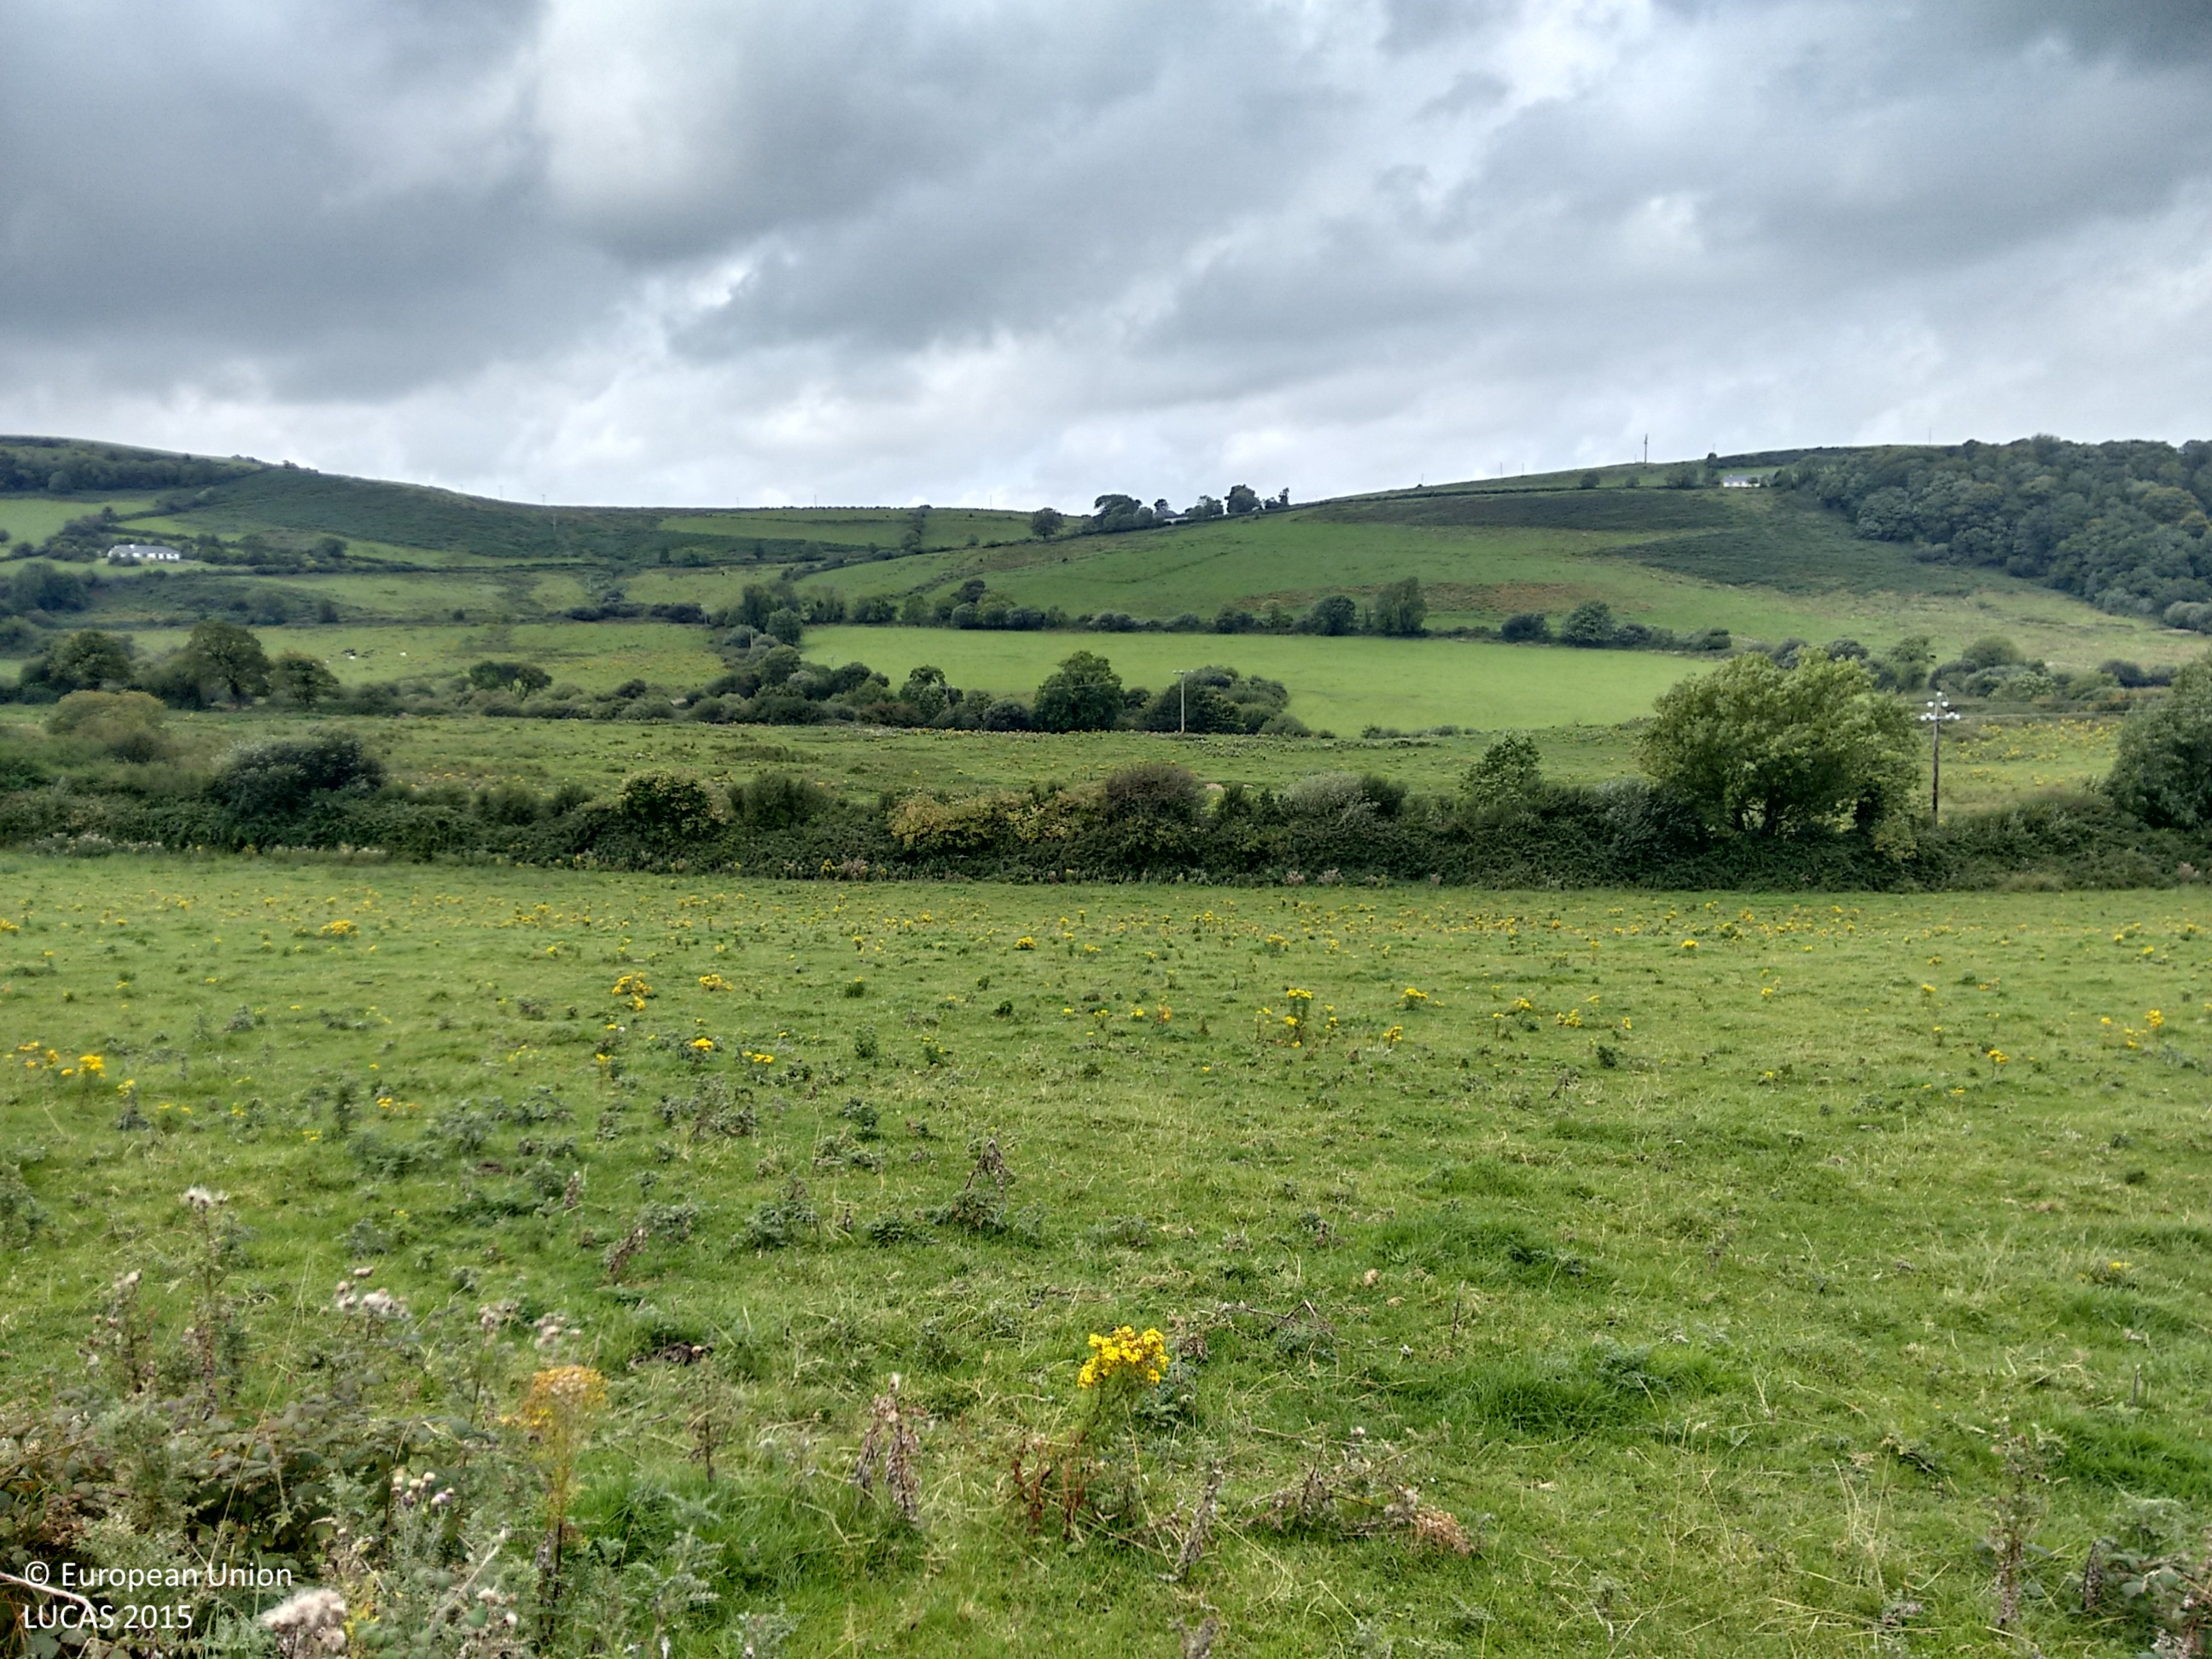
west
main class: Grassland
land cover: Grassland without tree/shrub cover
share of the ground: > 75 %
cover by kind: herbaceous plants 100 %
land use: Agriculture (excluding fallow land and kitchen gardens)
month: September
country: IE
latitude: 52.6001
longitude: -9.1006
